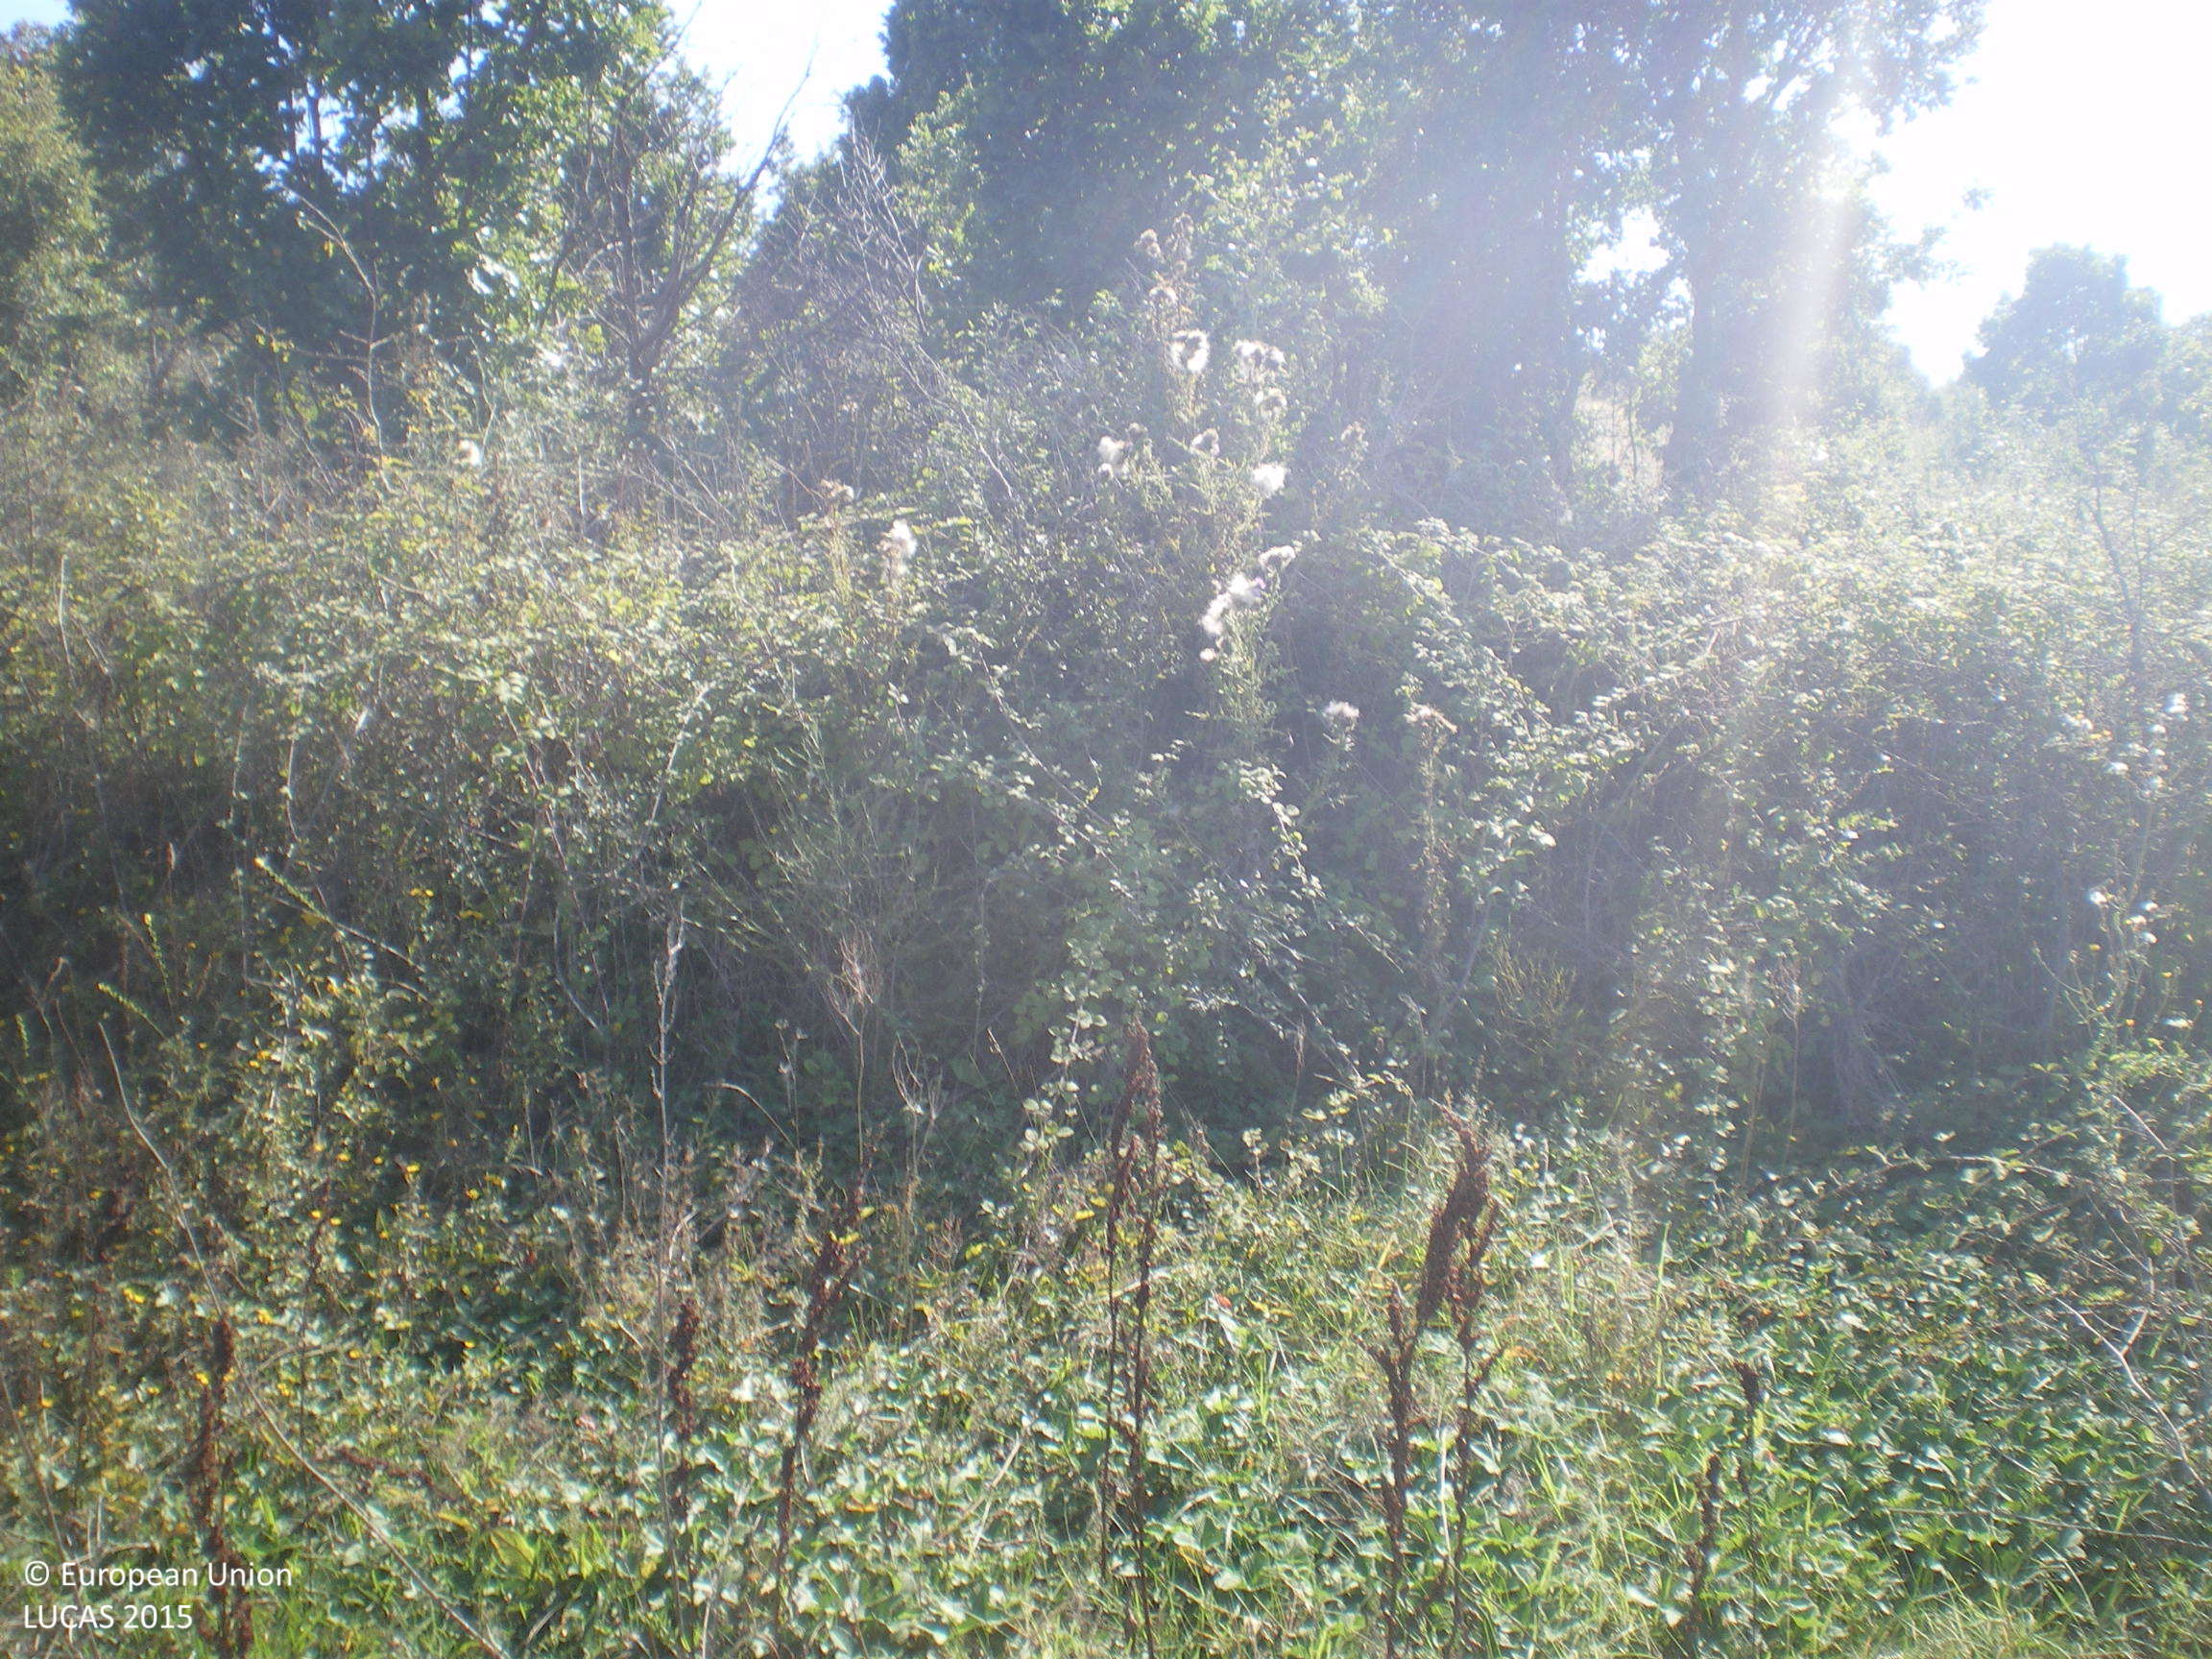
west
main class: Grassland
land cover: Grassland with sparse tree/shrub cover
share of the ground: > 75 %
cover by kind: herbaceous plants 85 %, shrubs 10 %, broadleaved forest trees 5 %
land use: Agriculture (excluding fallow land and kitchen gardens)
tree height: > 5 m
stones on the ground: < 10 %
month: September
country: BG
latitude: 41.8453
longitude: 26.0309
